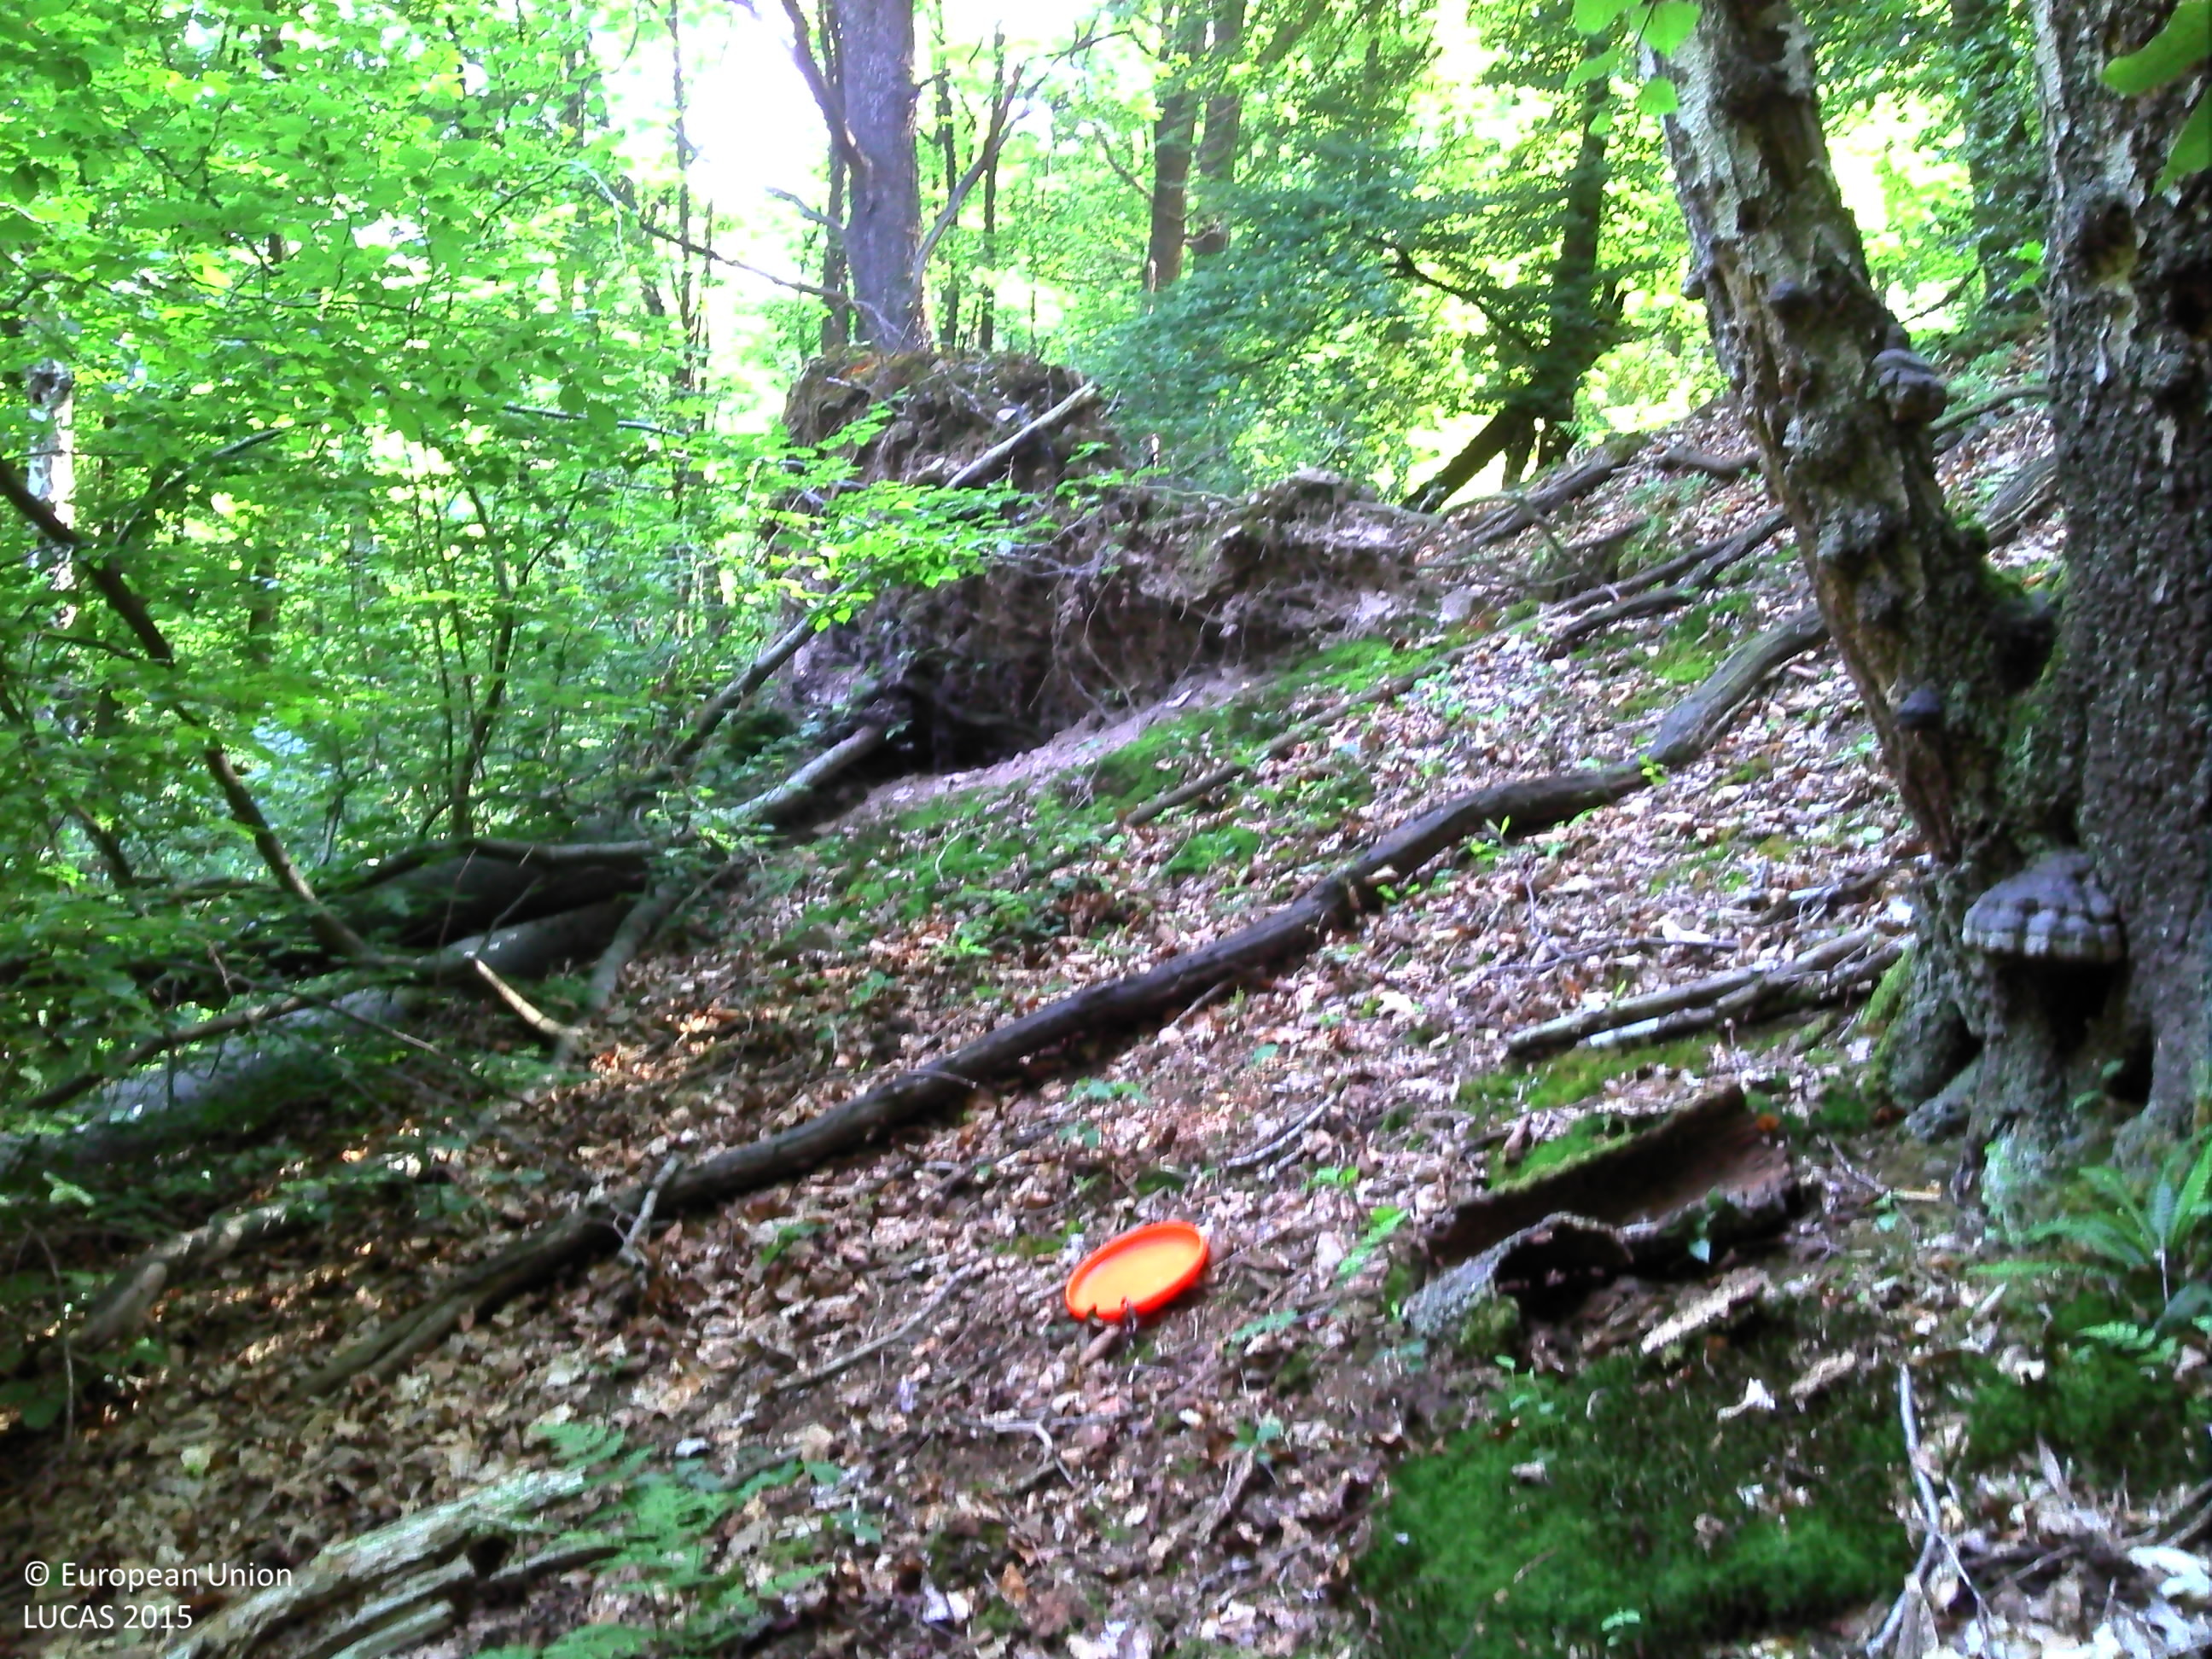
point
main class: Woodland
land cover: Broadleaved woodland
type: acidophilous oak and oak-birch forest
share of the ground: > 75 %
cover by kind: broadleaved forest trees 90 %, herbaceous plants 10 %
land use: Forestry
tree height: > 5 m
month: July
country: BE
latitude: 50.5552
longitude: 5.7501
